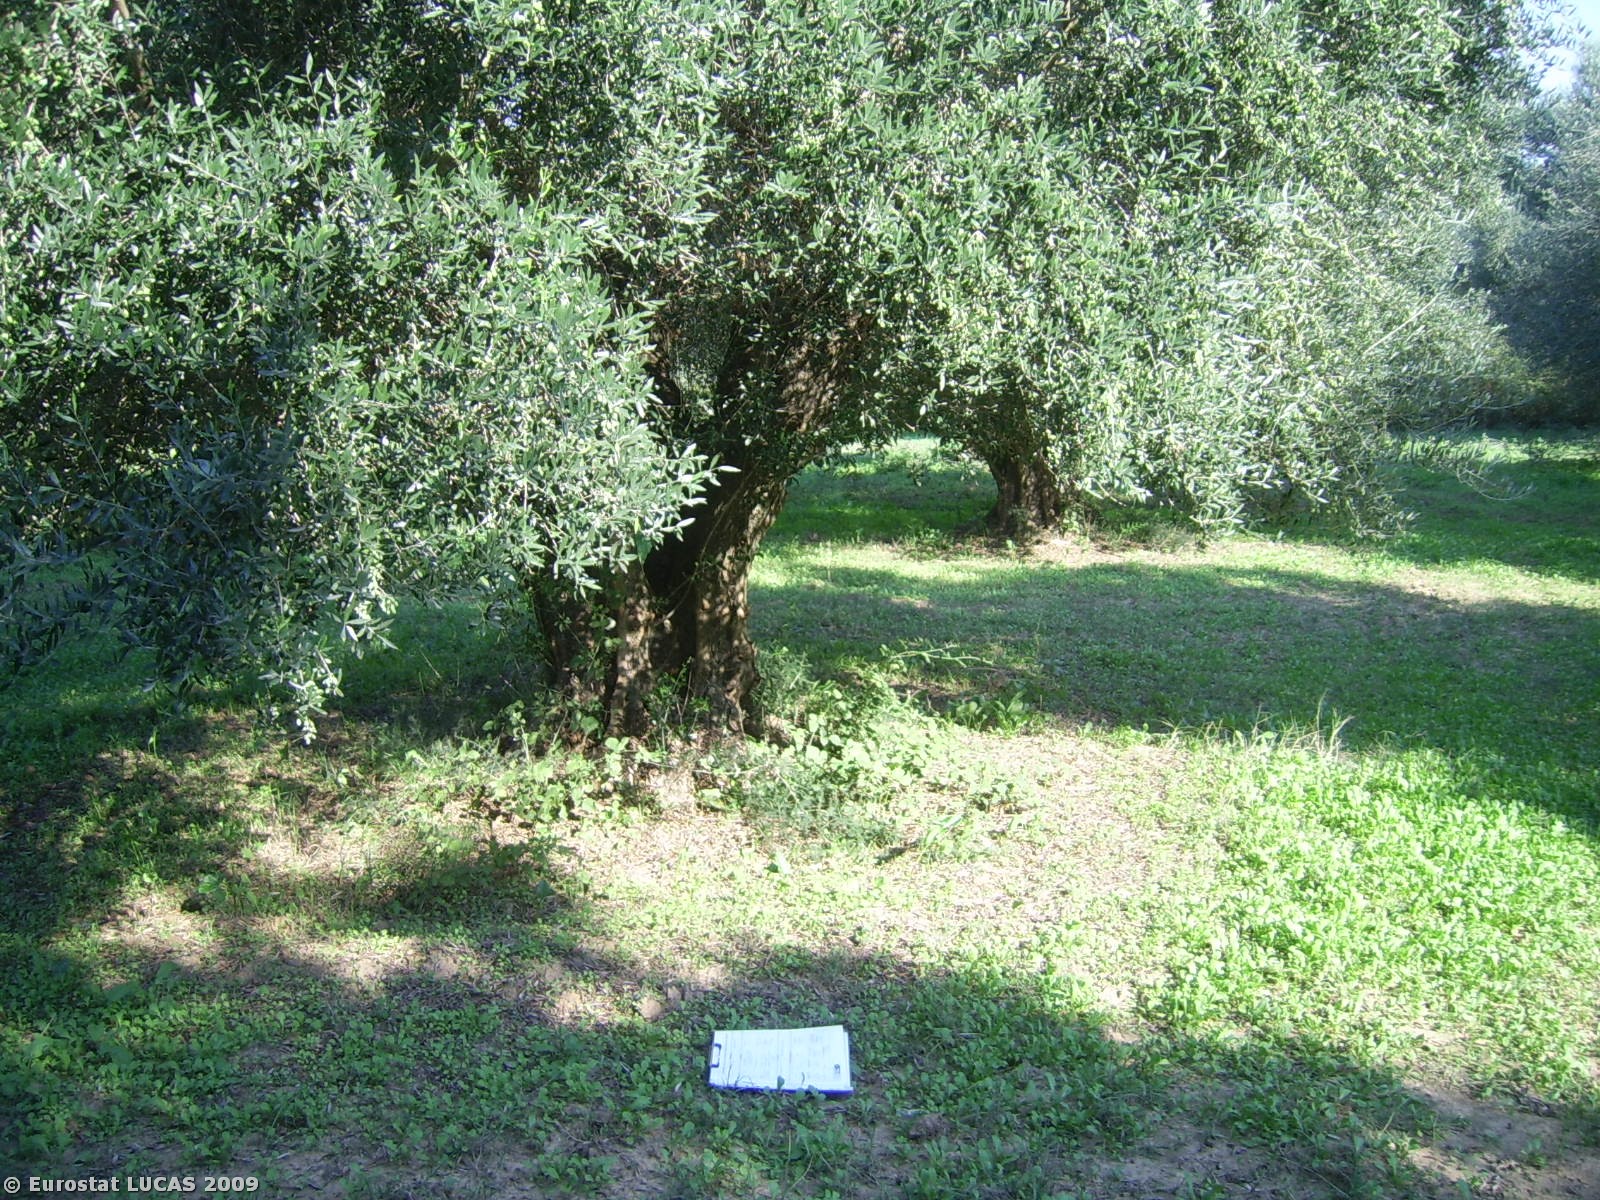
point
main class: Cropland
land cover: Olive groves
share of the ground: 50 - 75 %
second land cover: Grassland with sparse tree/shrub cover
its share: 25 - 50 %
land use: Agriculture (excluding fallow land and kitchen gardens)
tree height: < 5 m
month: October
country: GR
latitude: 37.8153
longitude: 21.3536
